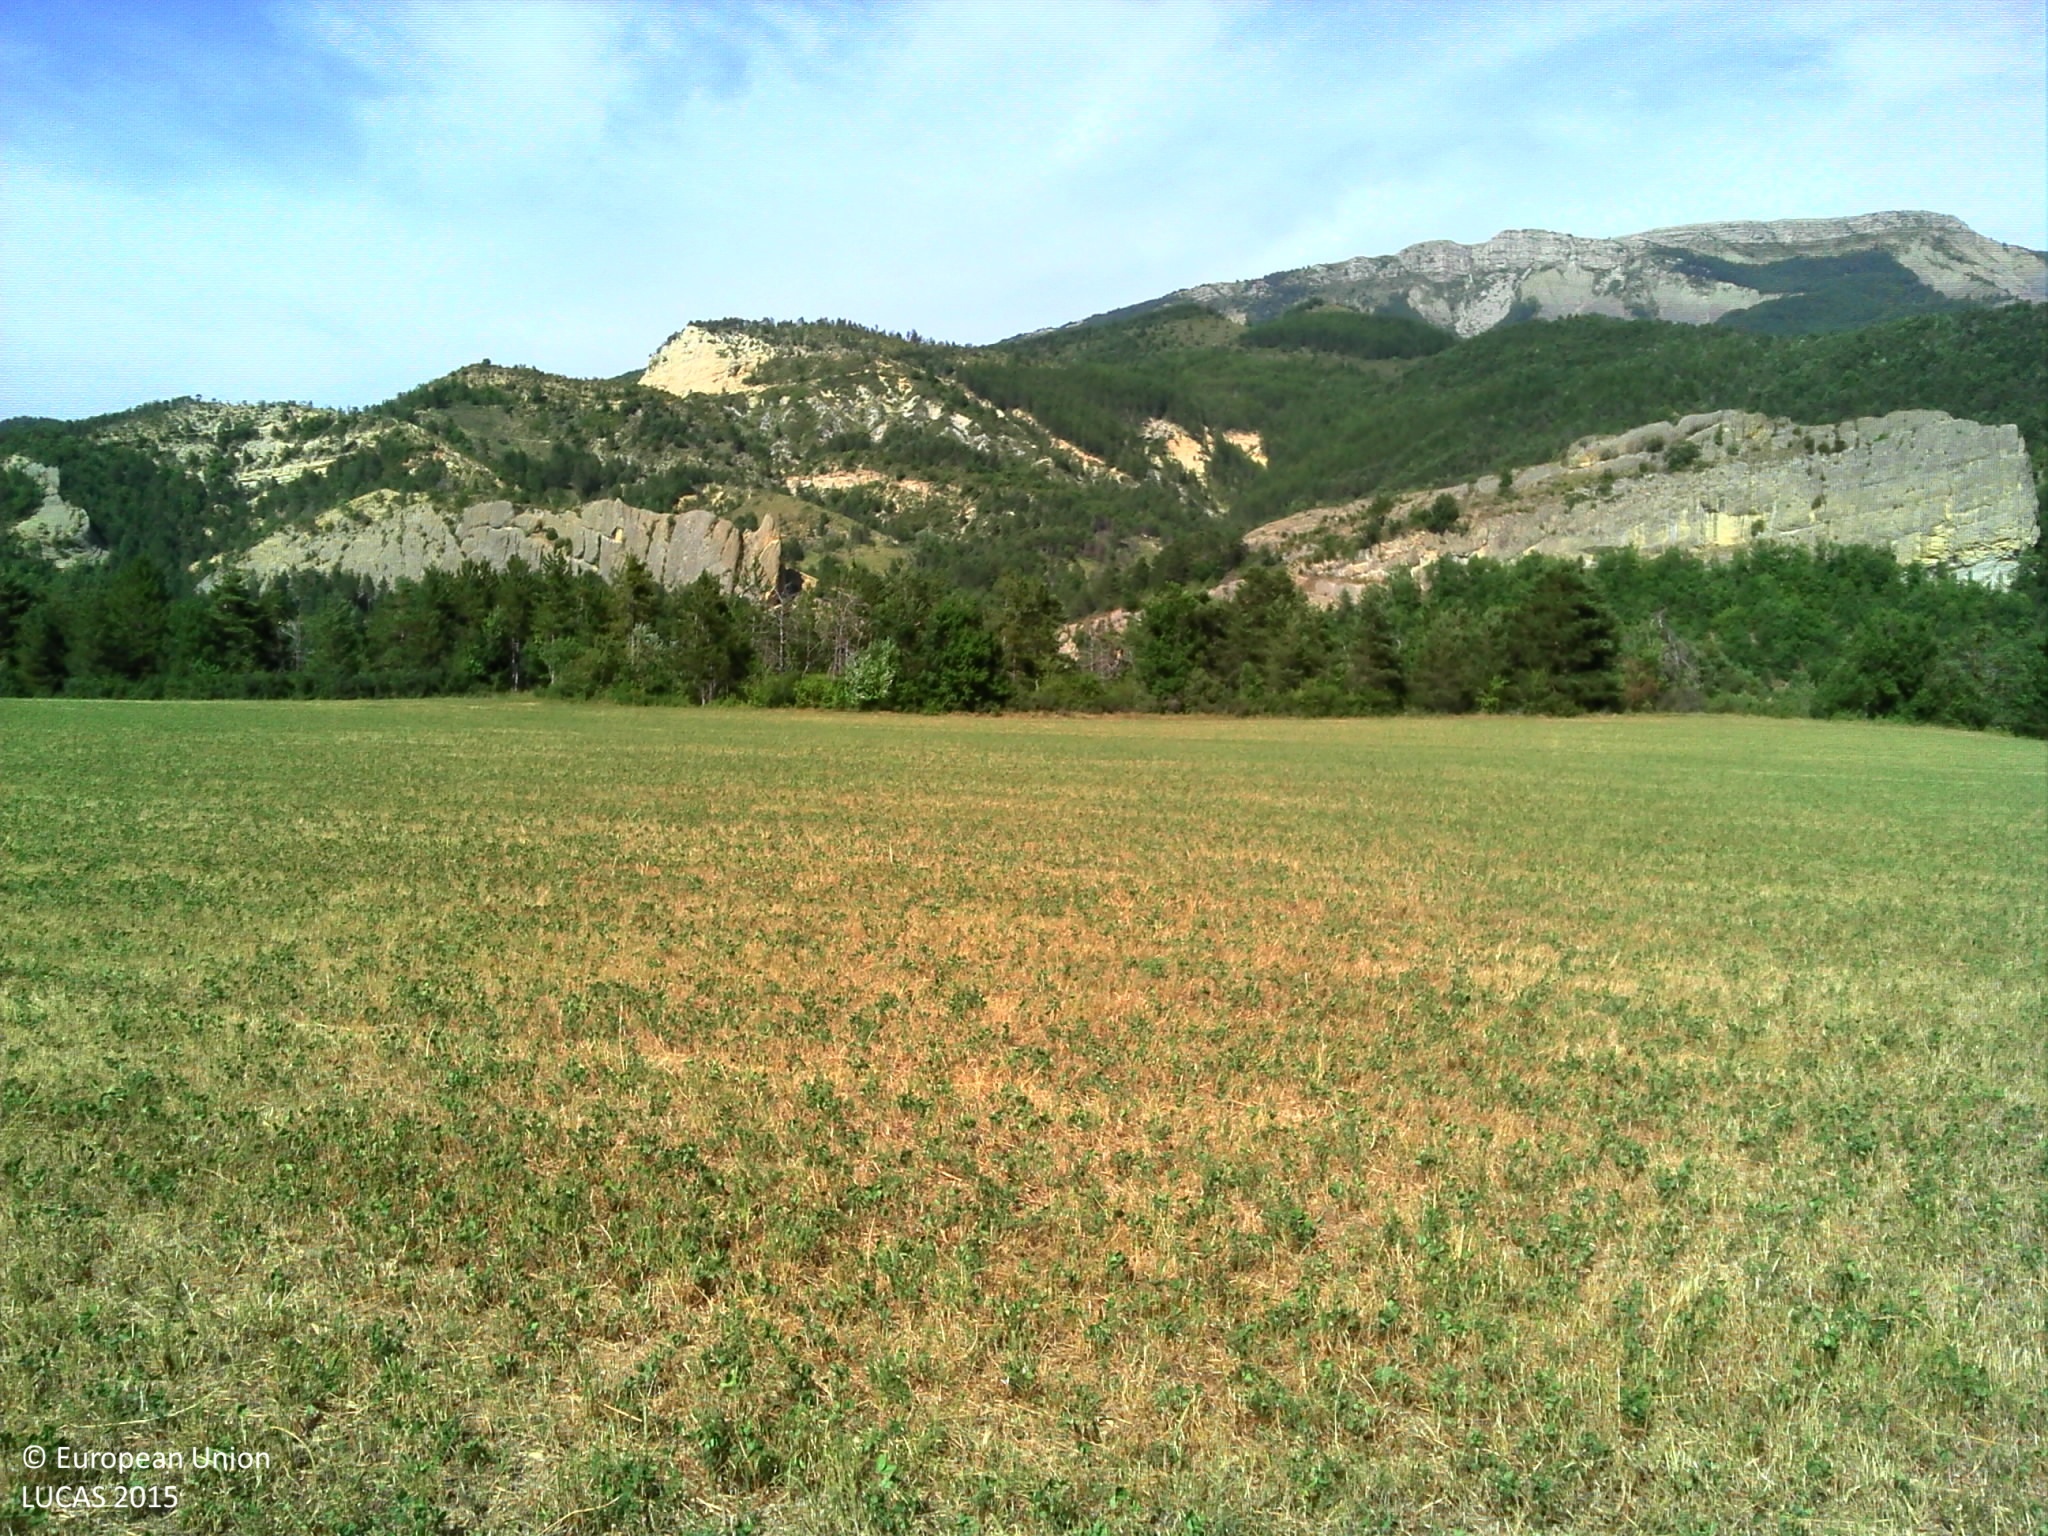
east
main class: Cropland
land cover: Temporary grasslands
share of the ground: > 75 %
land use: Agriculture (excluding fallow land and kitchen gardens)
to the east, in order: Temporary grasslands; Pine dominated mixed woodland; Grassland without tree/shrub cover; Tracks; Broadleaved woodland; Artificial constructions in urban areas; Broadleaved woodland
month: July
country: FR
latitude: 43.9093
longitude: 6.4091
